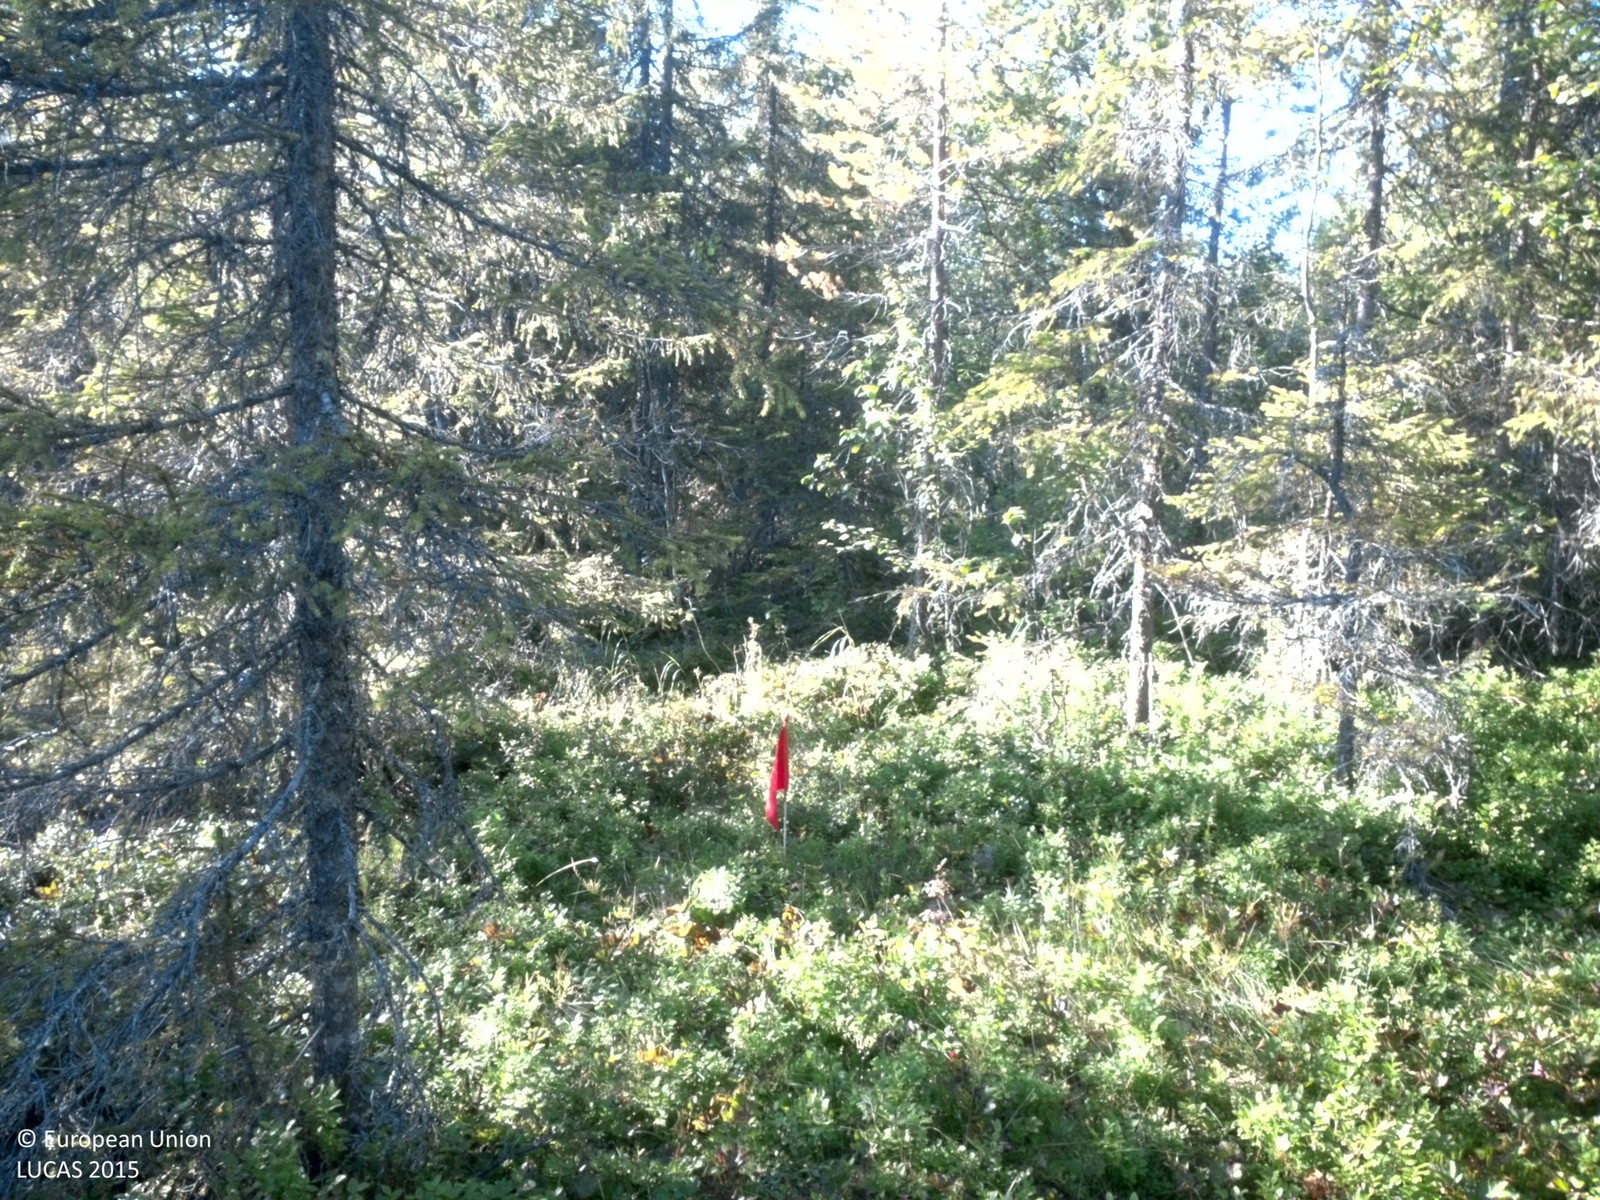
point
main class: Woodland
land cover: Spruce dominated mixed woodland
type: boreal forest
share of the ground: 50 - 75 %
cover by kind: coniferous forest trees 45 %, shrubs 30 %, broadleaved forest trees 15 %, herbaceous plants 5 %, lichens and mosses 5 %
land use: Forestry
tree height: > 5 m
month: August
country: SE
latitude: 64.4131
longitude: 18.3736
